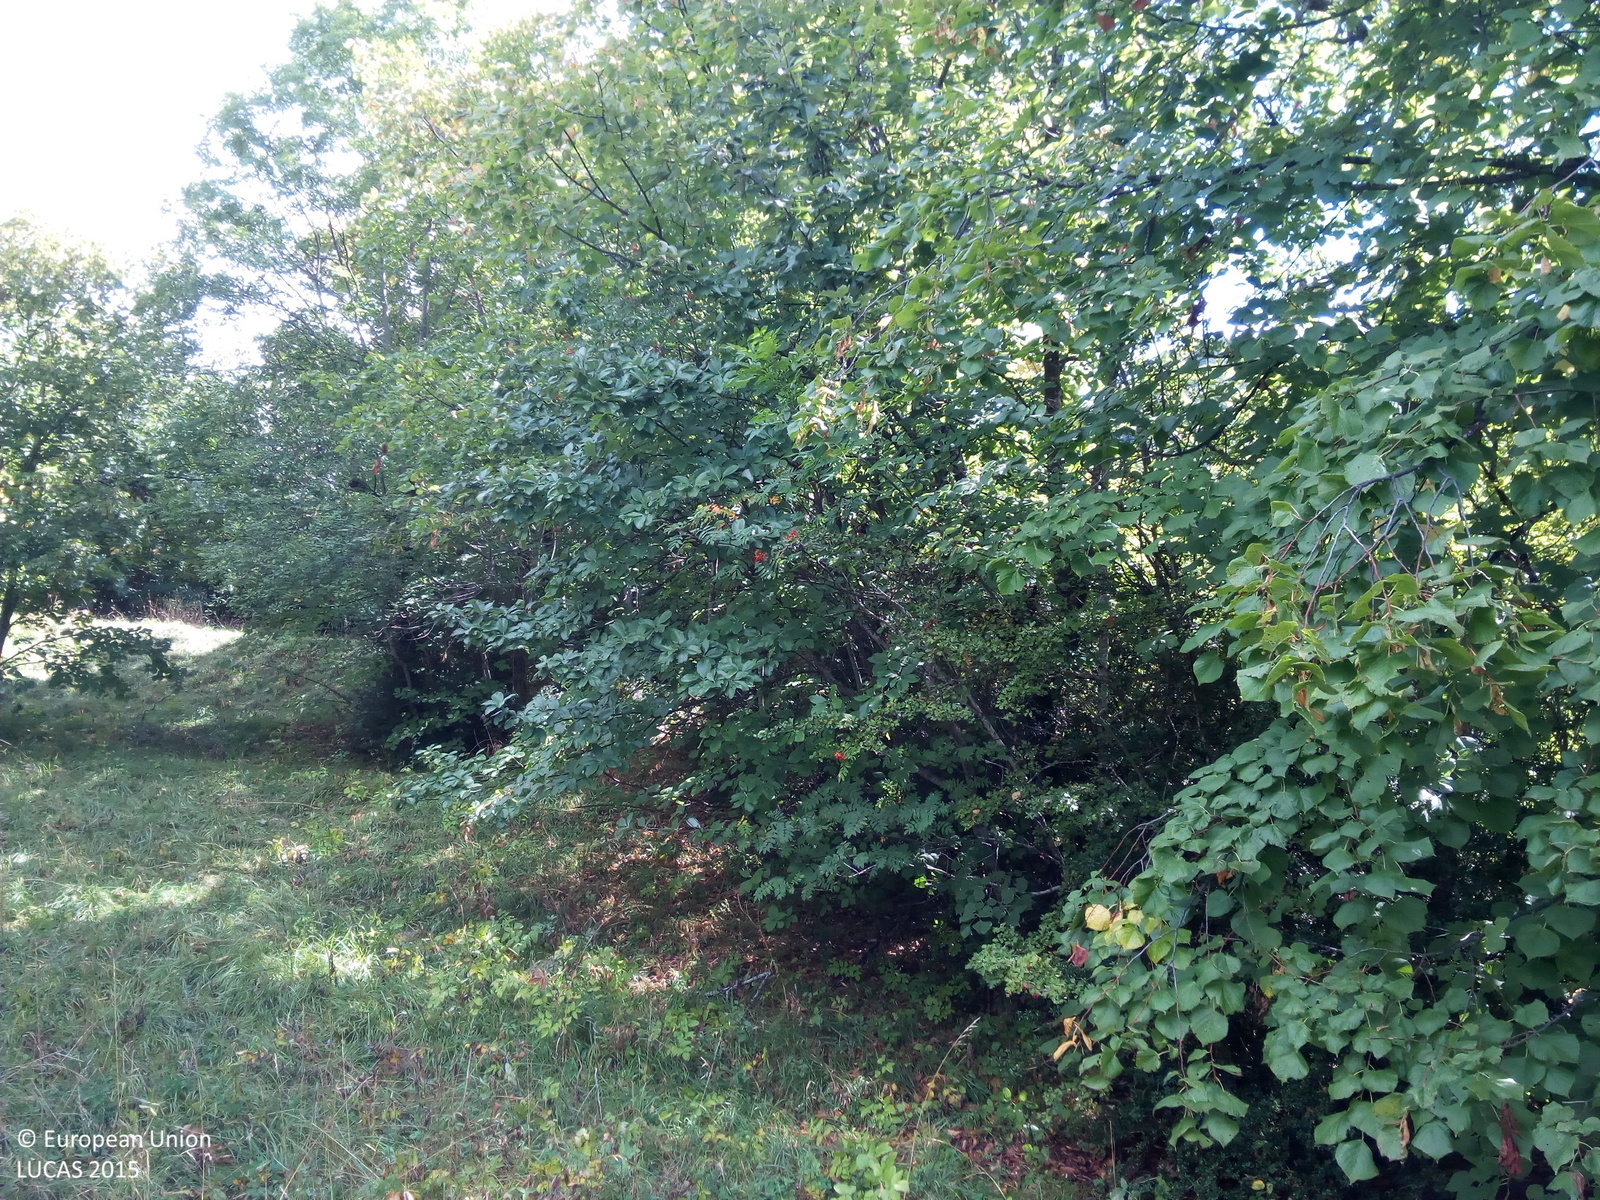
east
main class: Woodland
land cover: Broadleaved woodland
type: floodplain forest
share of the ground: > 75 %
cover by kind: broadleaved forest trees 80 %, herbaceous plants 15 %, shrubs 5 %
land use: Semi-natural and natural areas not in use
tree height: > 5 m
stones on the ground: < 10 %
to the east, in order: Broadleaved woodland; Grassland without tree/shrub cover; Broadleaved woodland; Grassland without tree/shrub cover; Single bushes/trees; Grassland with sparse tree/shrub cover; Single bushes/trees; Grassland without tree/shrub cover; Broadleaved woodland; Rivers and streams; Broadleaved woodland
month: September
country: ES
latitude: 42.5755
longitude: 0.3665
